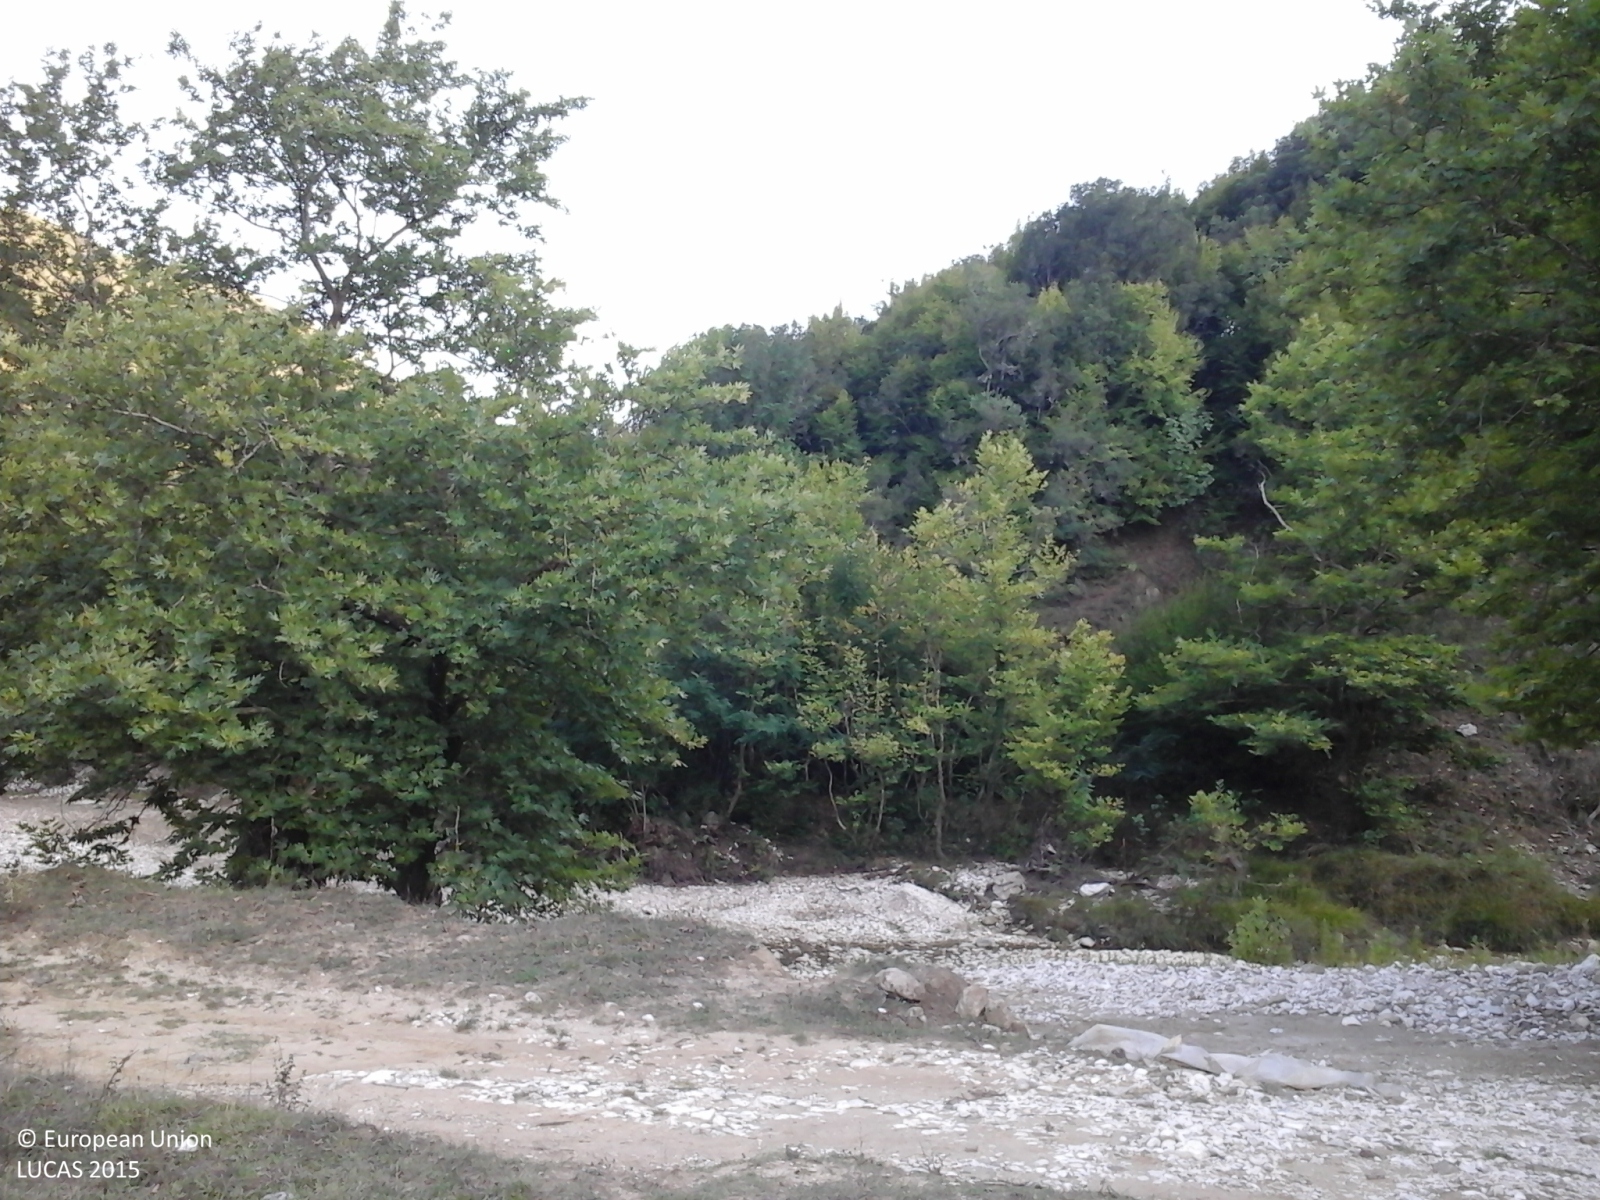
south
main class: Woodland
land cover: Broadleaved woodland
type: broadleaved evergreen forest
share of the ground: > 75 %
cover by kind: broadleaved forest trees 80 %, shrubs 10 %, unconsolidated bare surface 10 %
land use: Forestry
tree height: > 5 m
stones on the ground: < 10 %
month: September
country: GR
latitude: 39.6480
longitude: 20.6637
